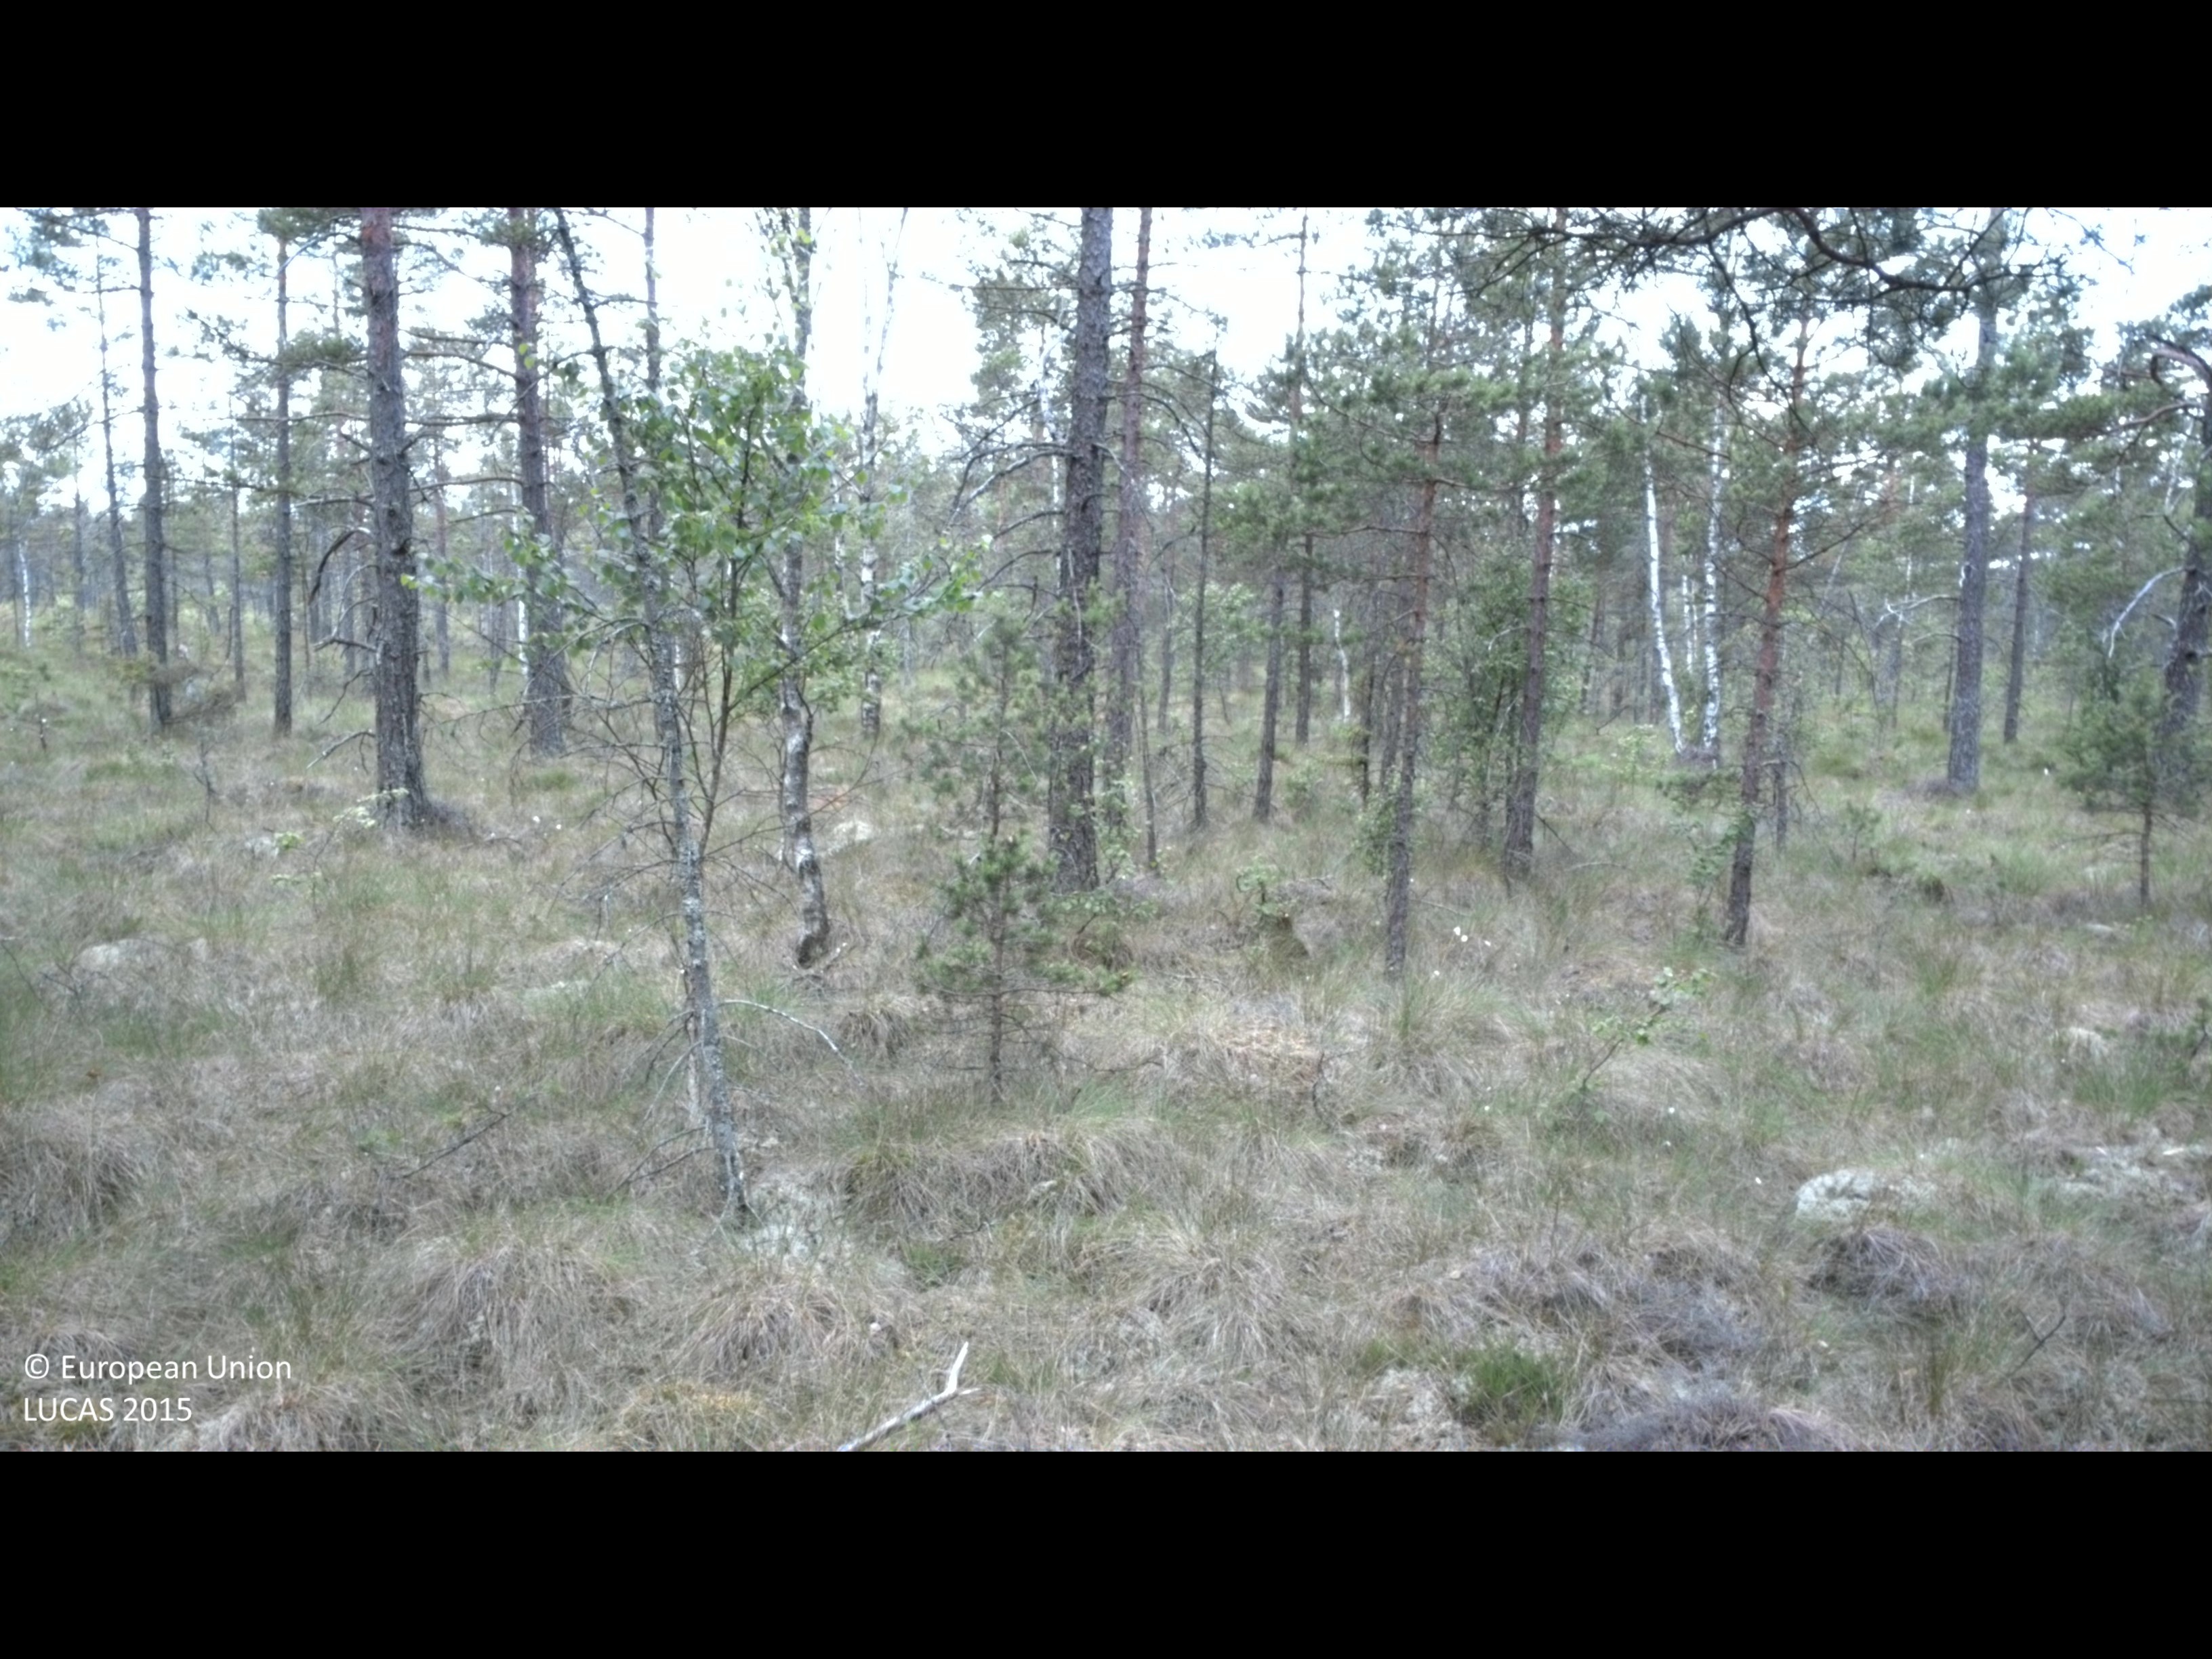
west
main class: Woodland
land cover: Pine dominated mixed woodland
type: mire and swamp forests
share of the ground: 50 - 75 %
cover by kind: coniferous forest trees 40 %, broadleaved forest trees 20 %, herbaceous plants 20 %, shrubs 10 %, lichens and mosses 10 %
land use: Semi-natural and natural areas not in use
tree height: > 5 m
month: July
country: SE
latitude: 56.5667
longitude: 14.2772
